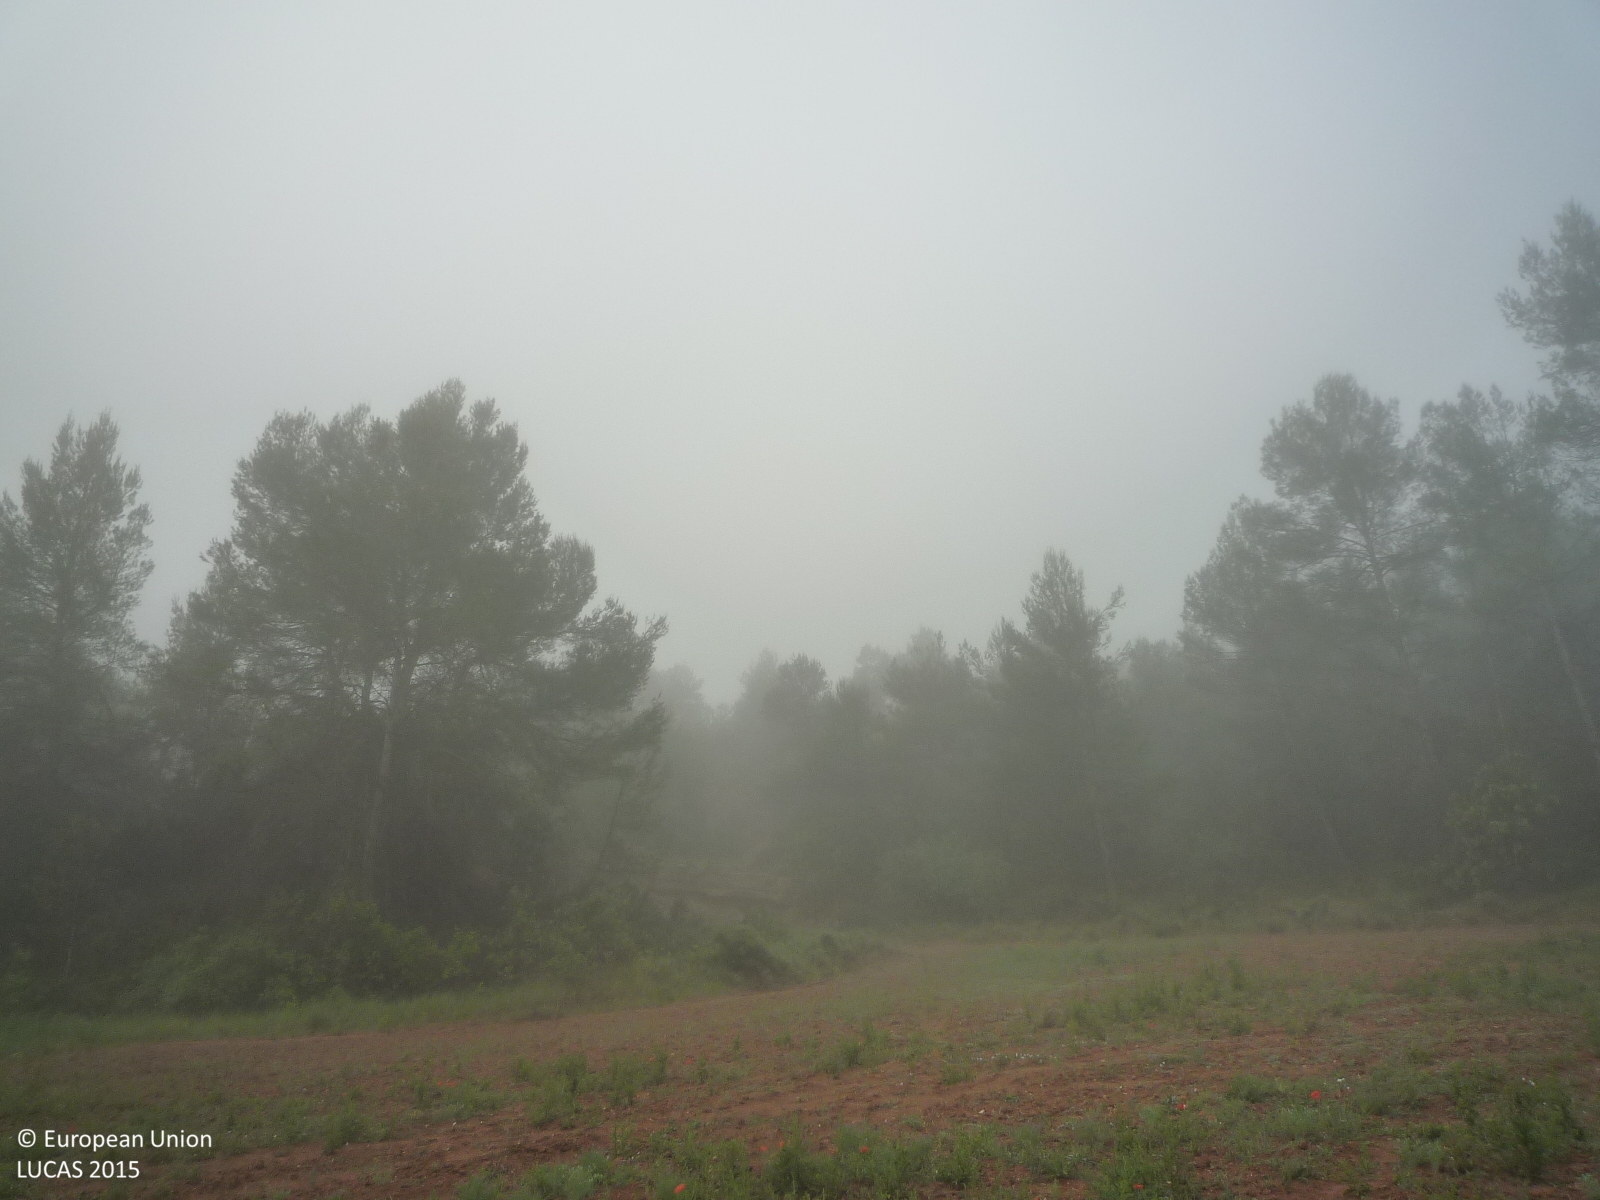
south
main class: Grassland
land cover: Grassland without tree/shrub cover
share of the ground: > 75 %
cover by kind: herbaceous plants 100 %
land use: Abandoned areas
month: June
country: ES
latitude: 41.6648
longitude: 1.7646
